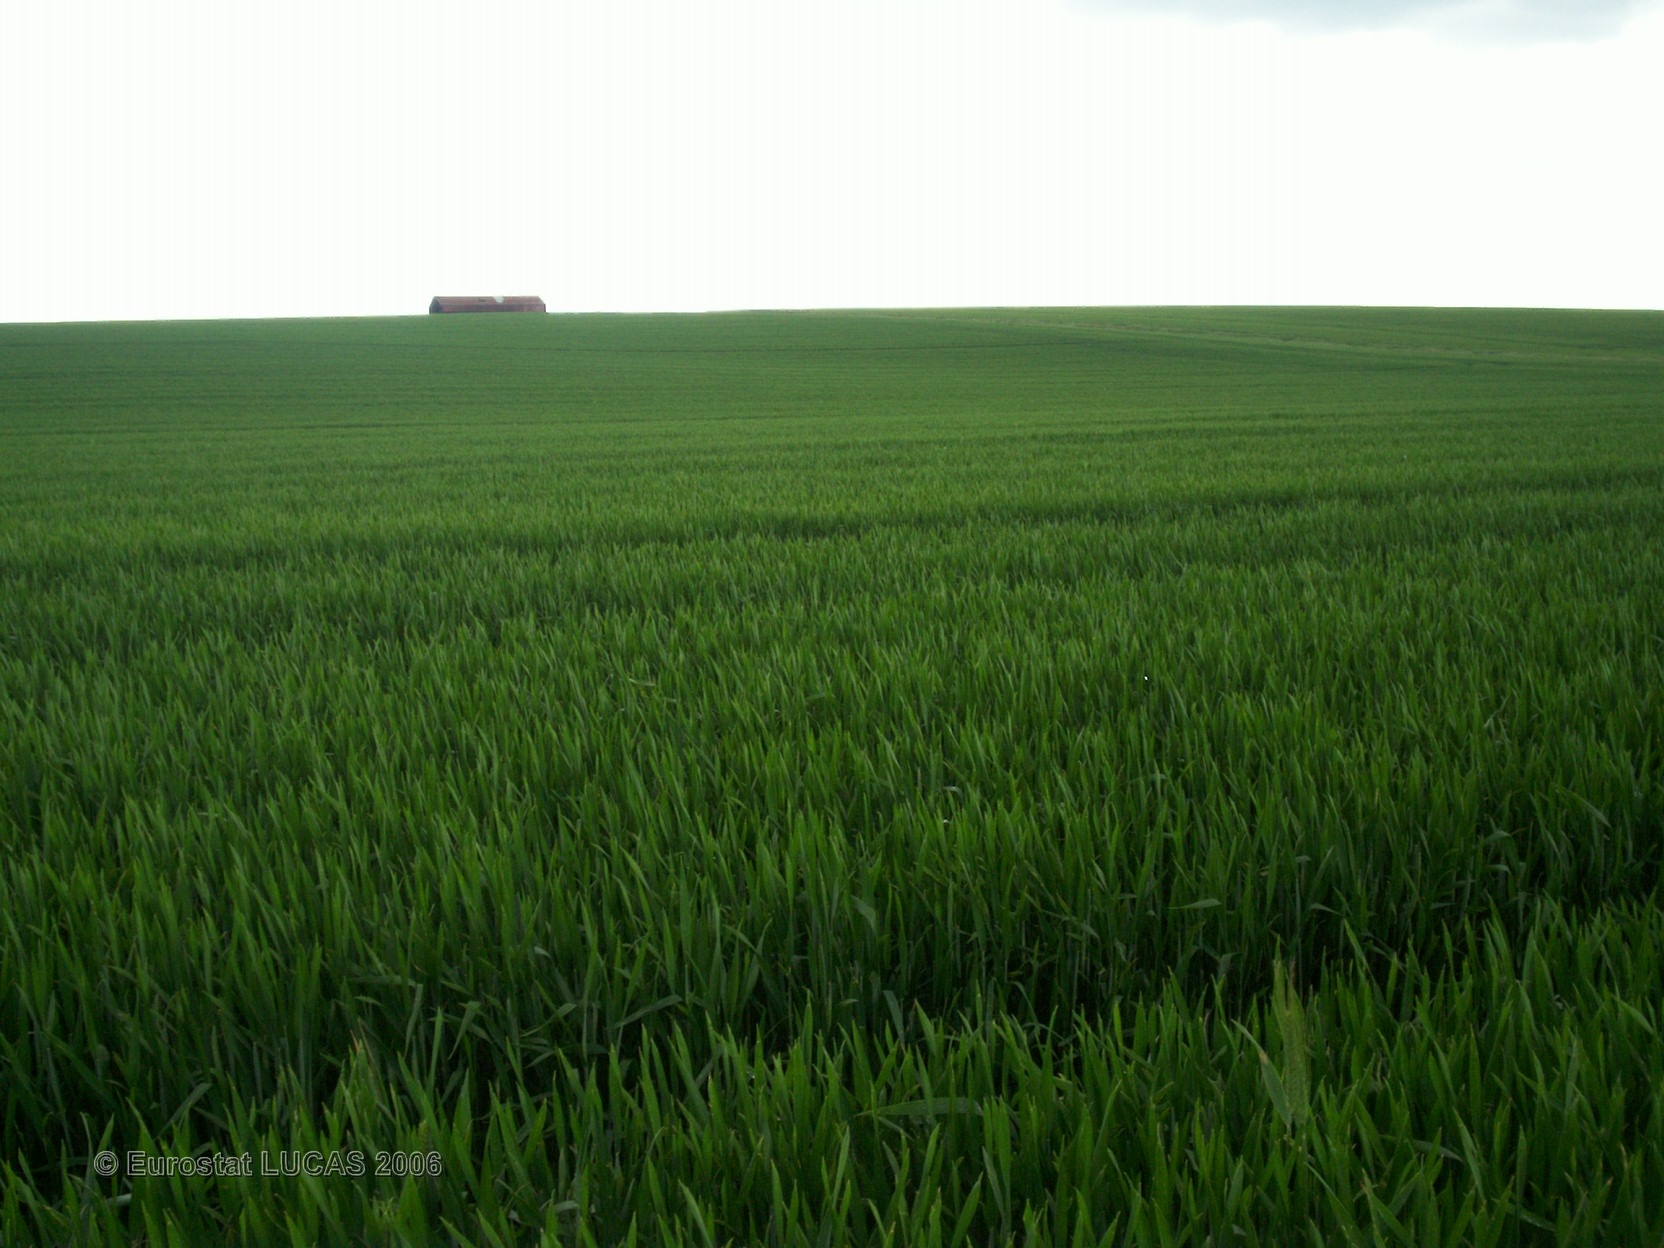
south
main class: Cropland
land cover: Common wheat
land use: Agriculture (excluding fallow land and kitchen gardens)
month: May
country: FR
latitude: 49.2890
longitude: 3.7106
